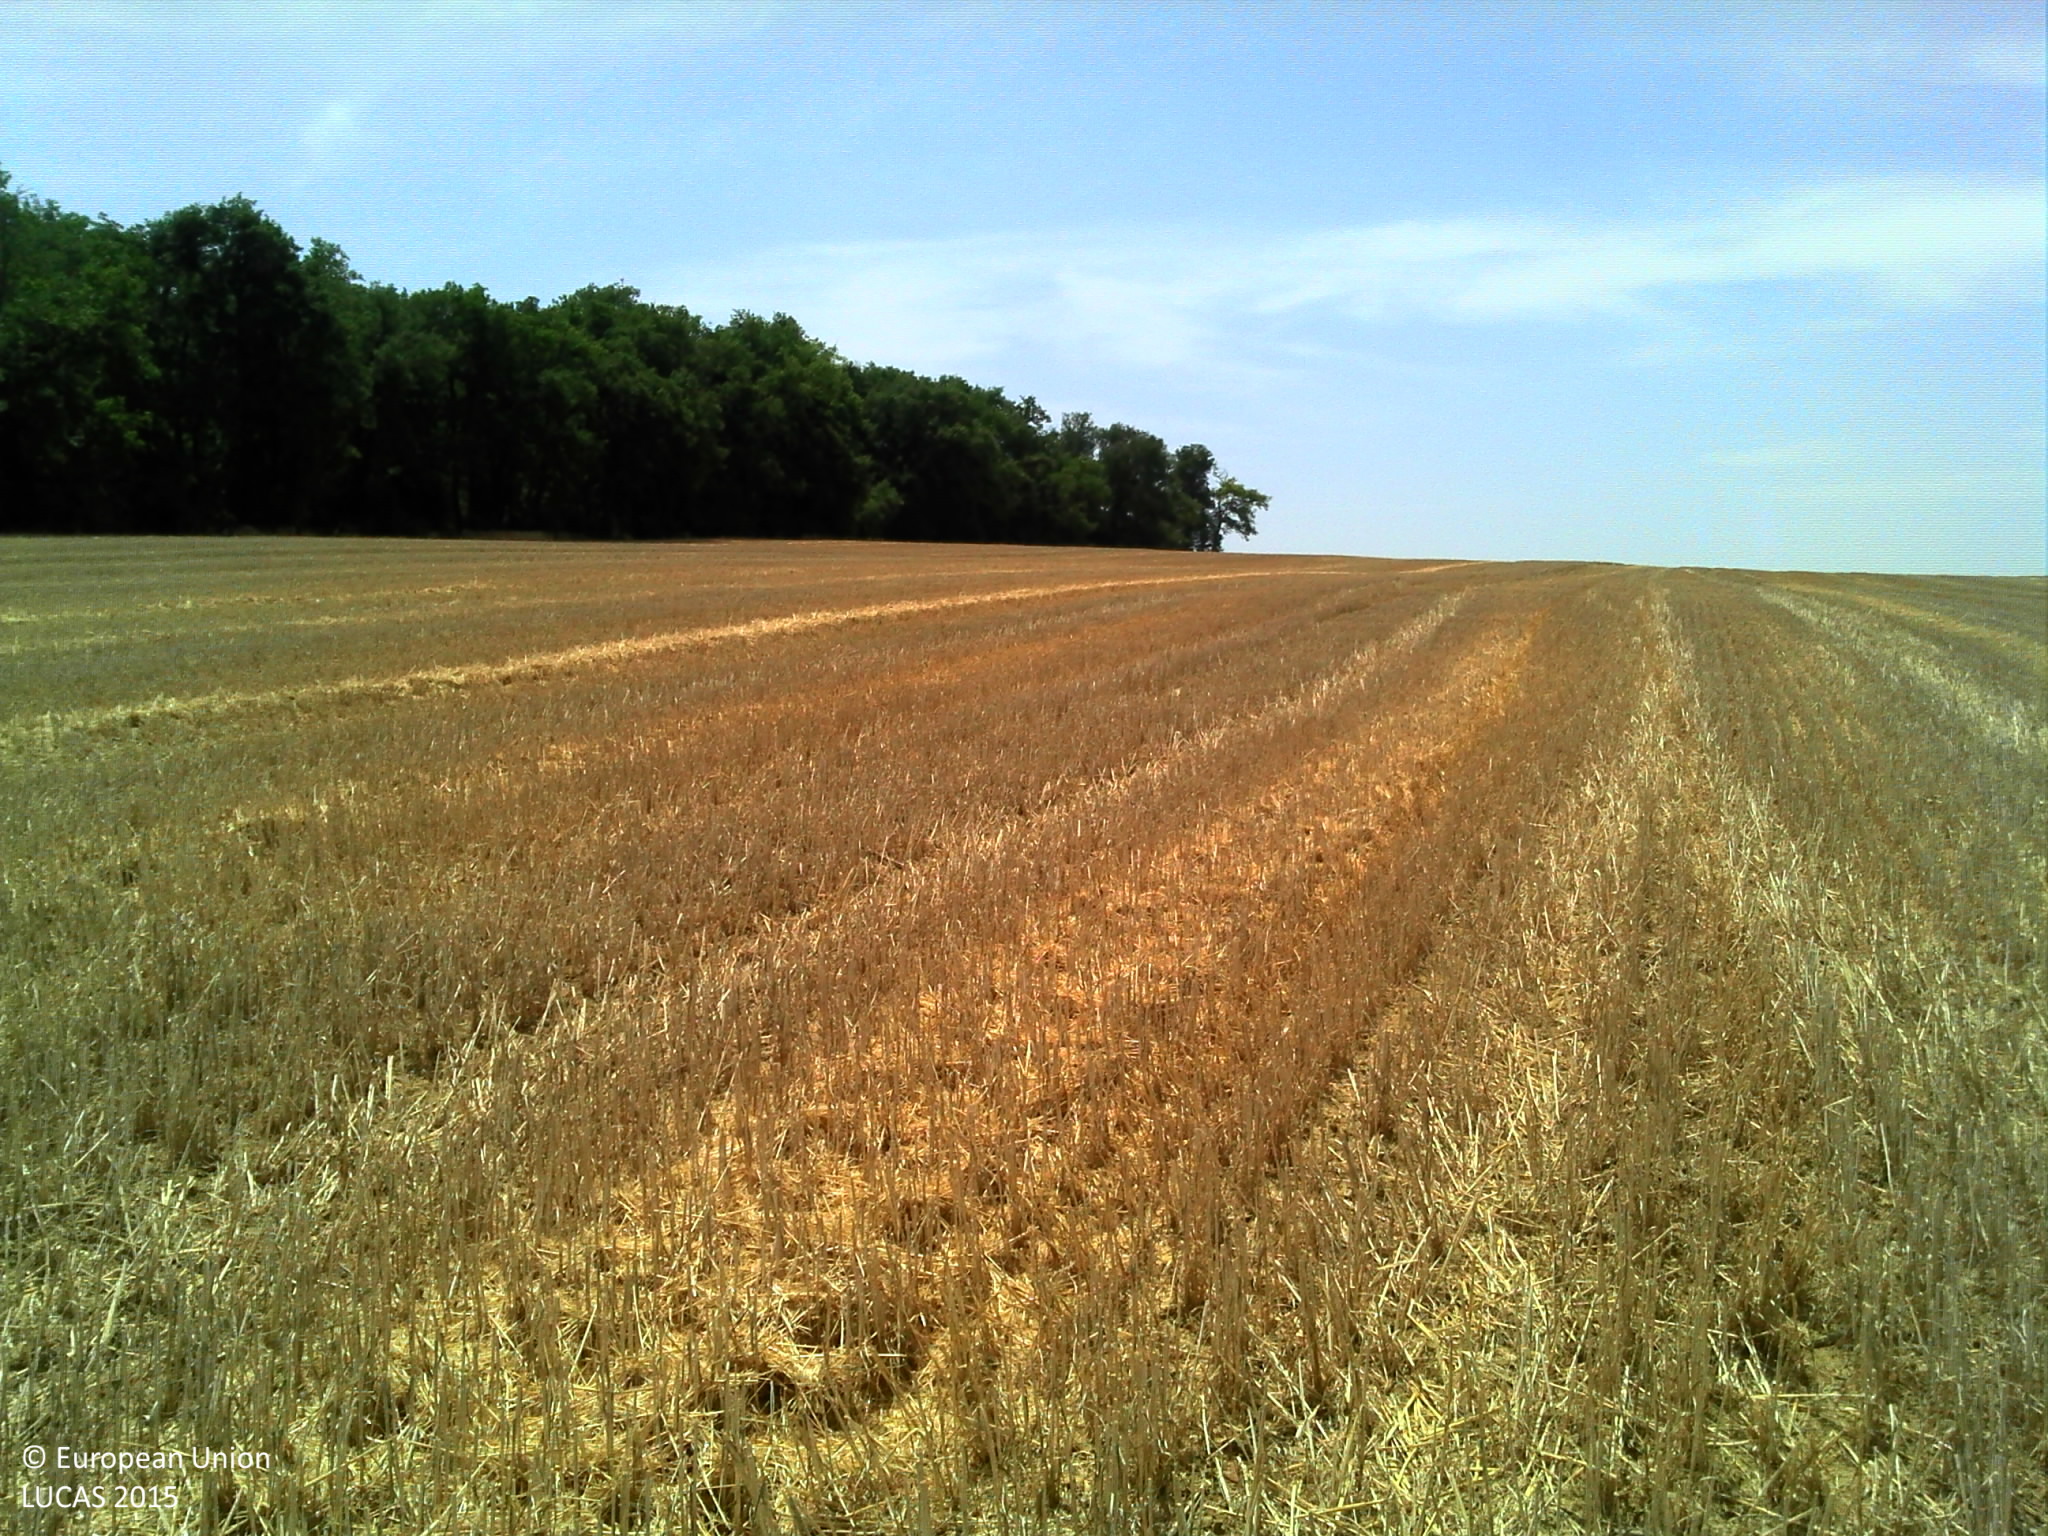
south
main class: Cropland
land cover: Durum wheat
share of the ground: > 75 %
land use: Agriculture (excluding fallow land and kitchen gardens)
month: July
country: FR
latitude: 43.5640
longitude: 1.0497
